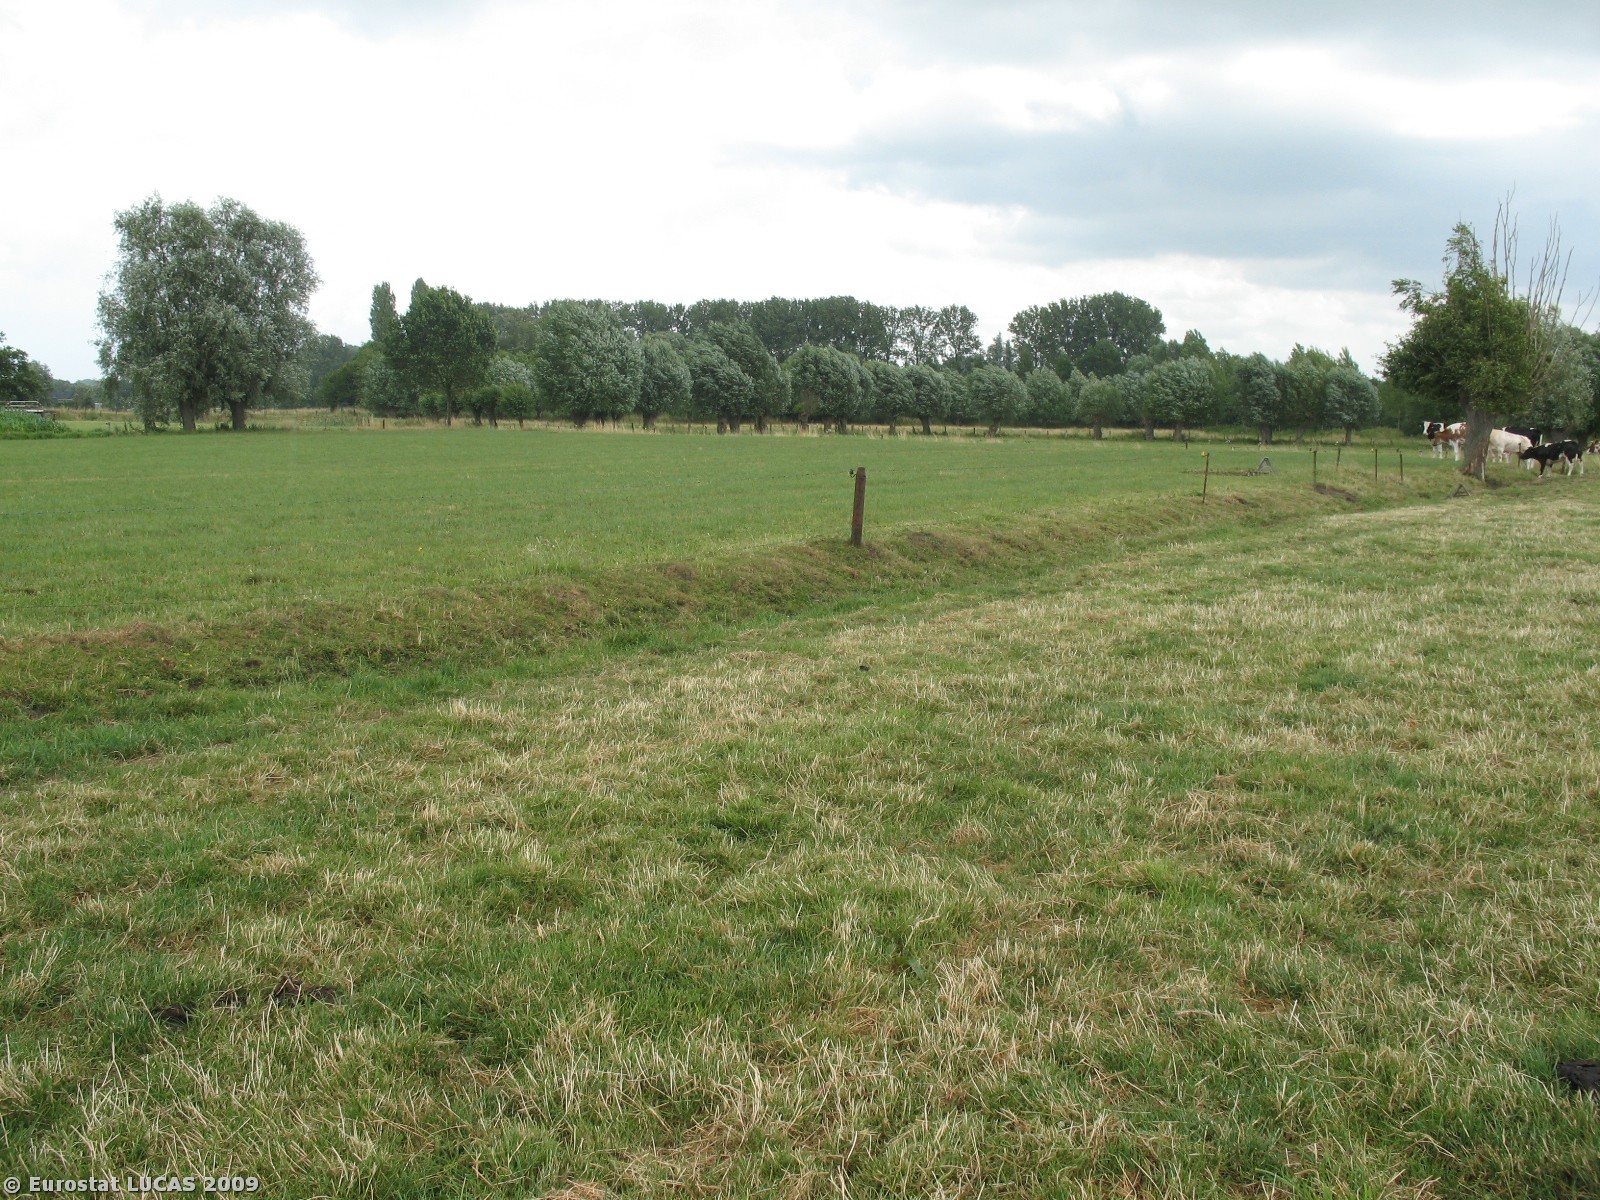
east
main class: Grassland
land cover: Grassland without tree/shrub cover
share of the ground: > 75 %
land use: Agriculture (excluding fallow land and kitchen gardens)
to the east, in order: Grassland without tree/shrub cover; Ditches and canals; Fences; Grassland without tree/shrub cover; Fences; Grassland without tree/shrub cover; Fences; Grassland without tree/shrub cover
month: June
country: BE
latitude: 50.9845
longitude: 3.7110
